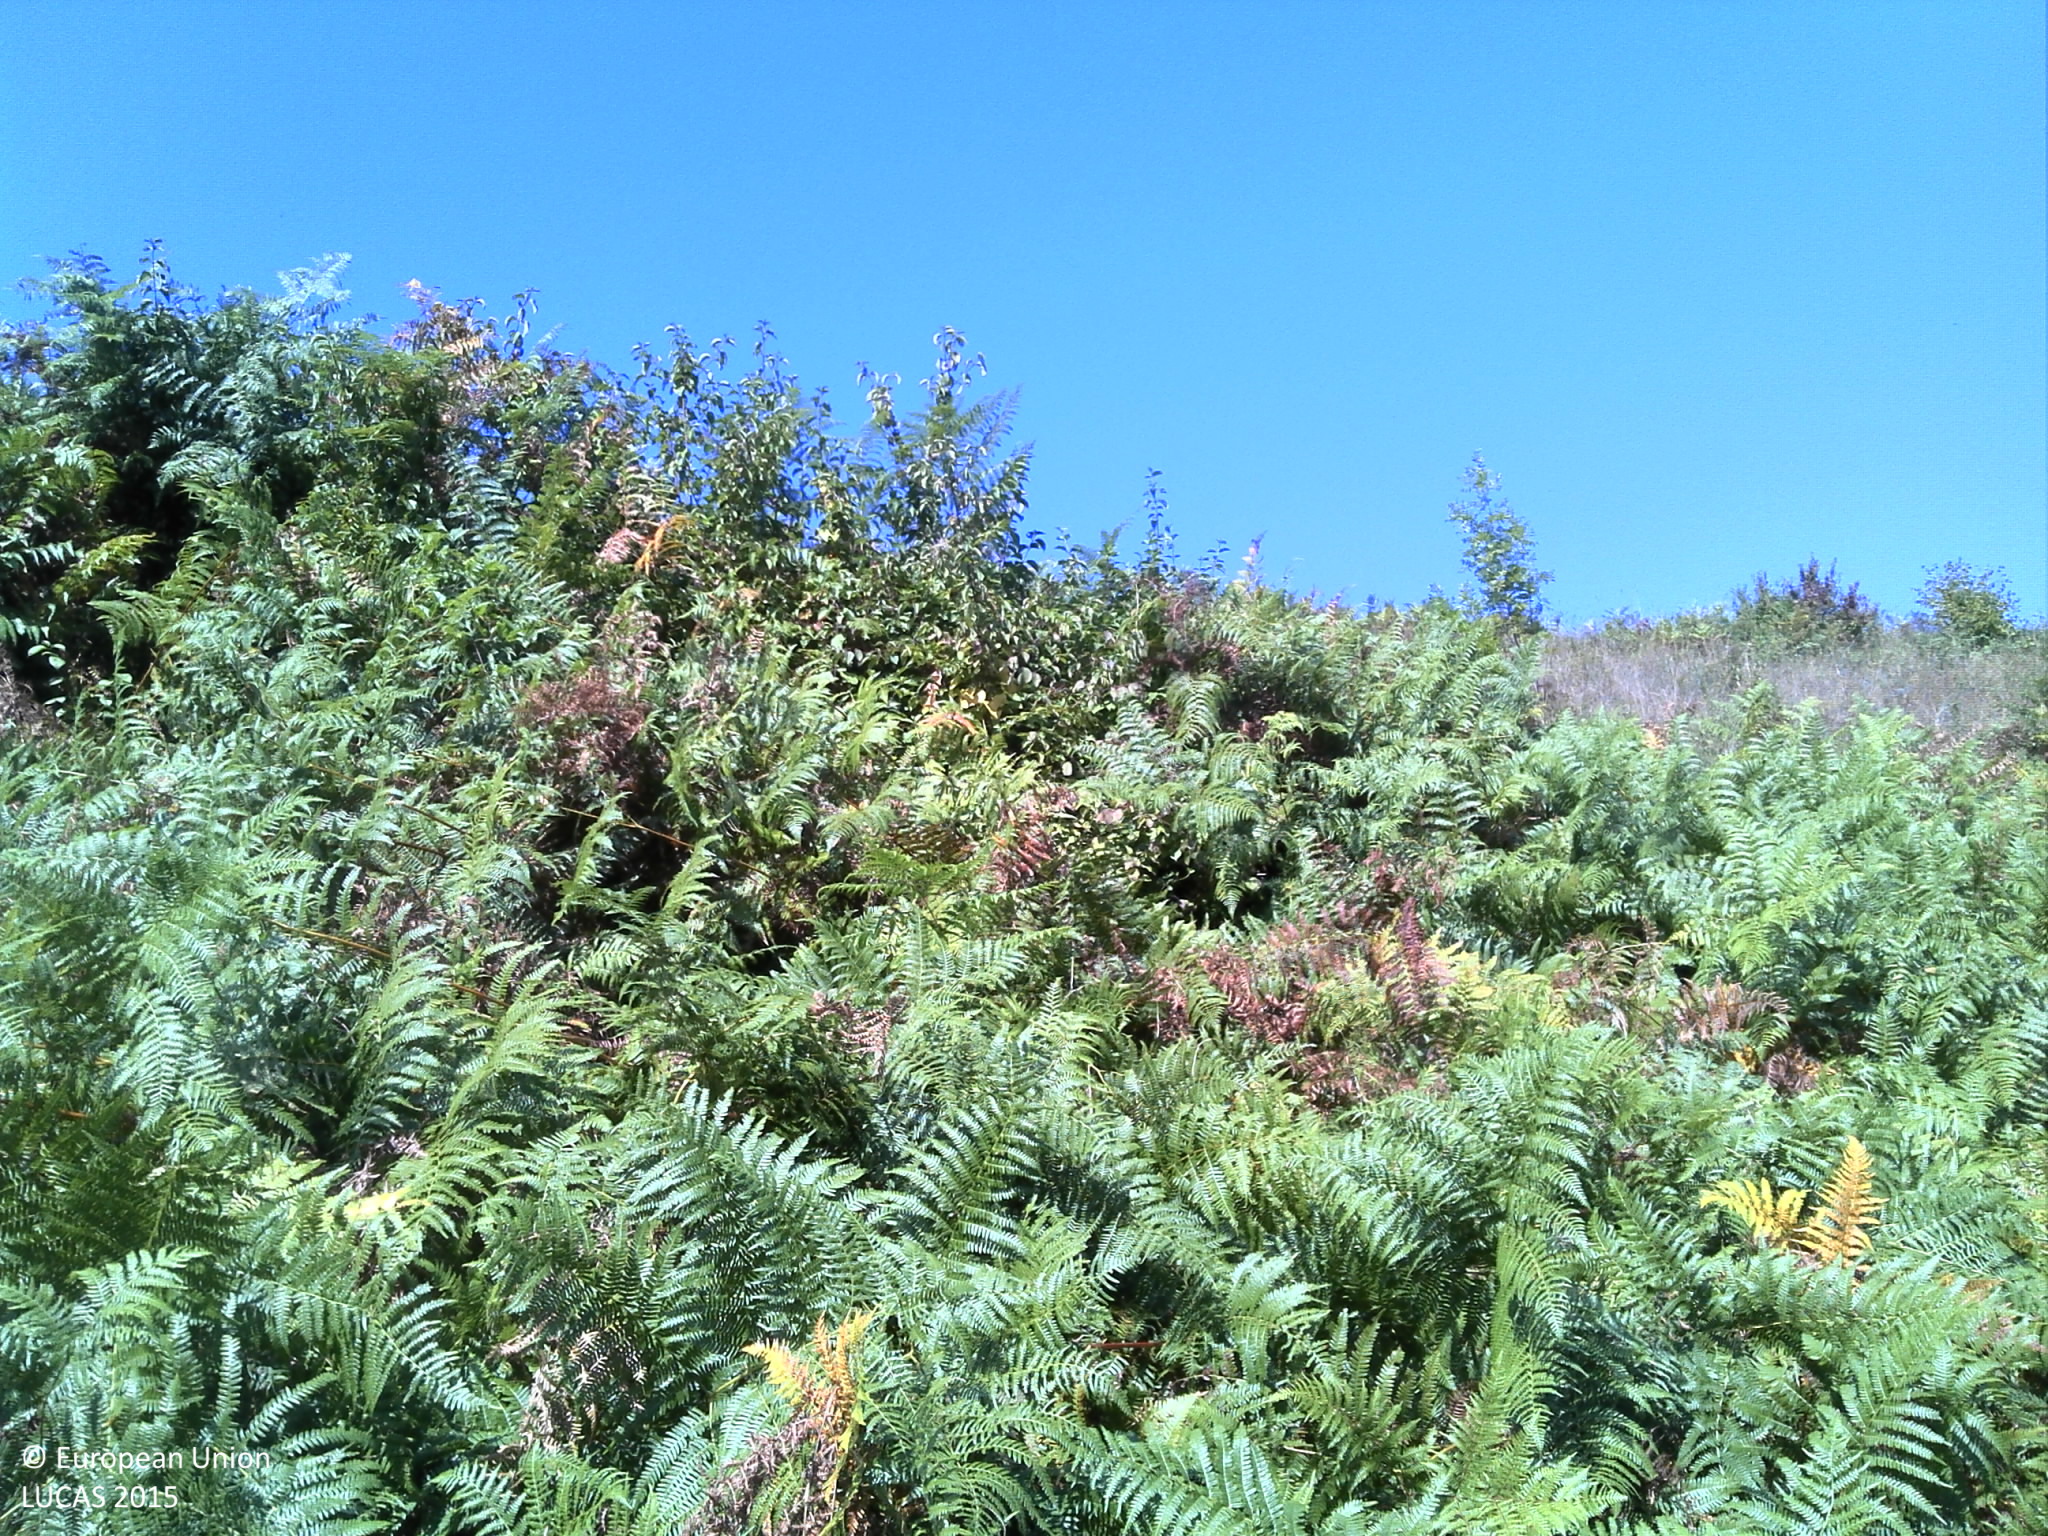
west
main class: Shrubland
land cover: Shrubland without tree cover
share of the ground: > 75 %
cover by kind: shrubs 100 %
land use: Semi-natural and natural areas not in use
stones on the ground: < 10 %
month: September
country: HR
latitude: 44.9564
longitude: 15.6358
